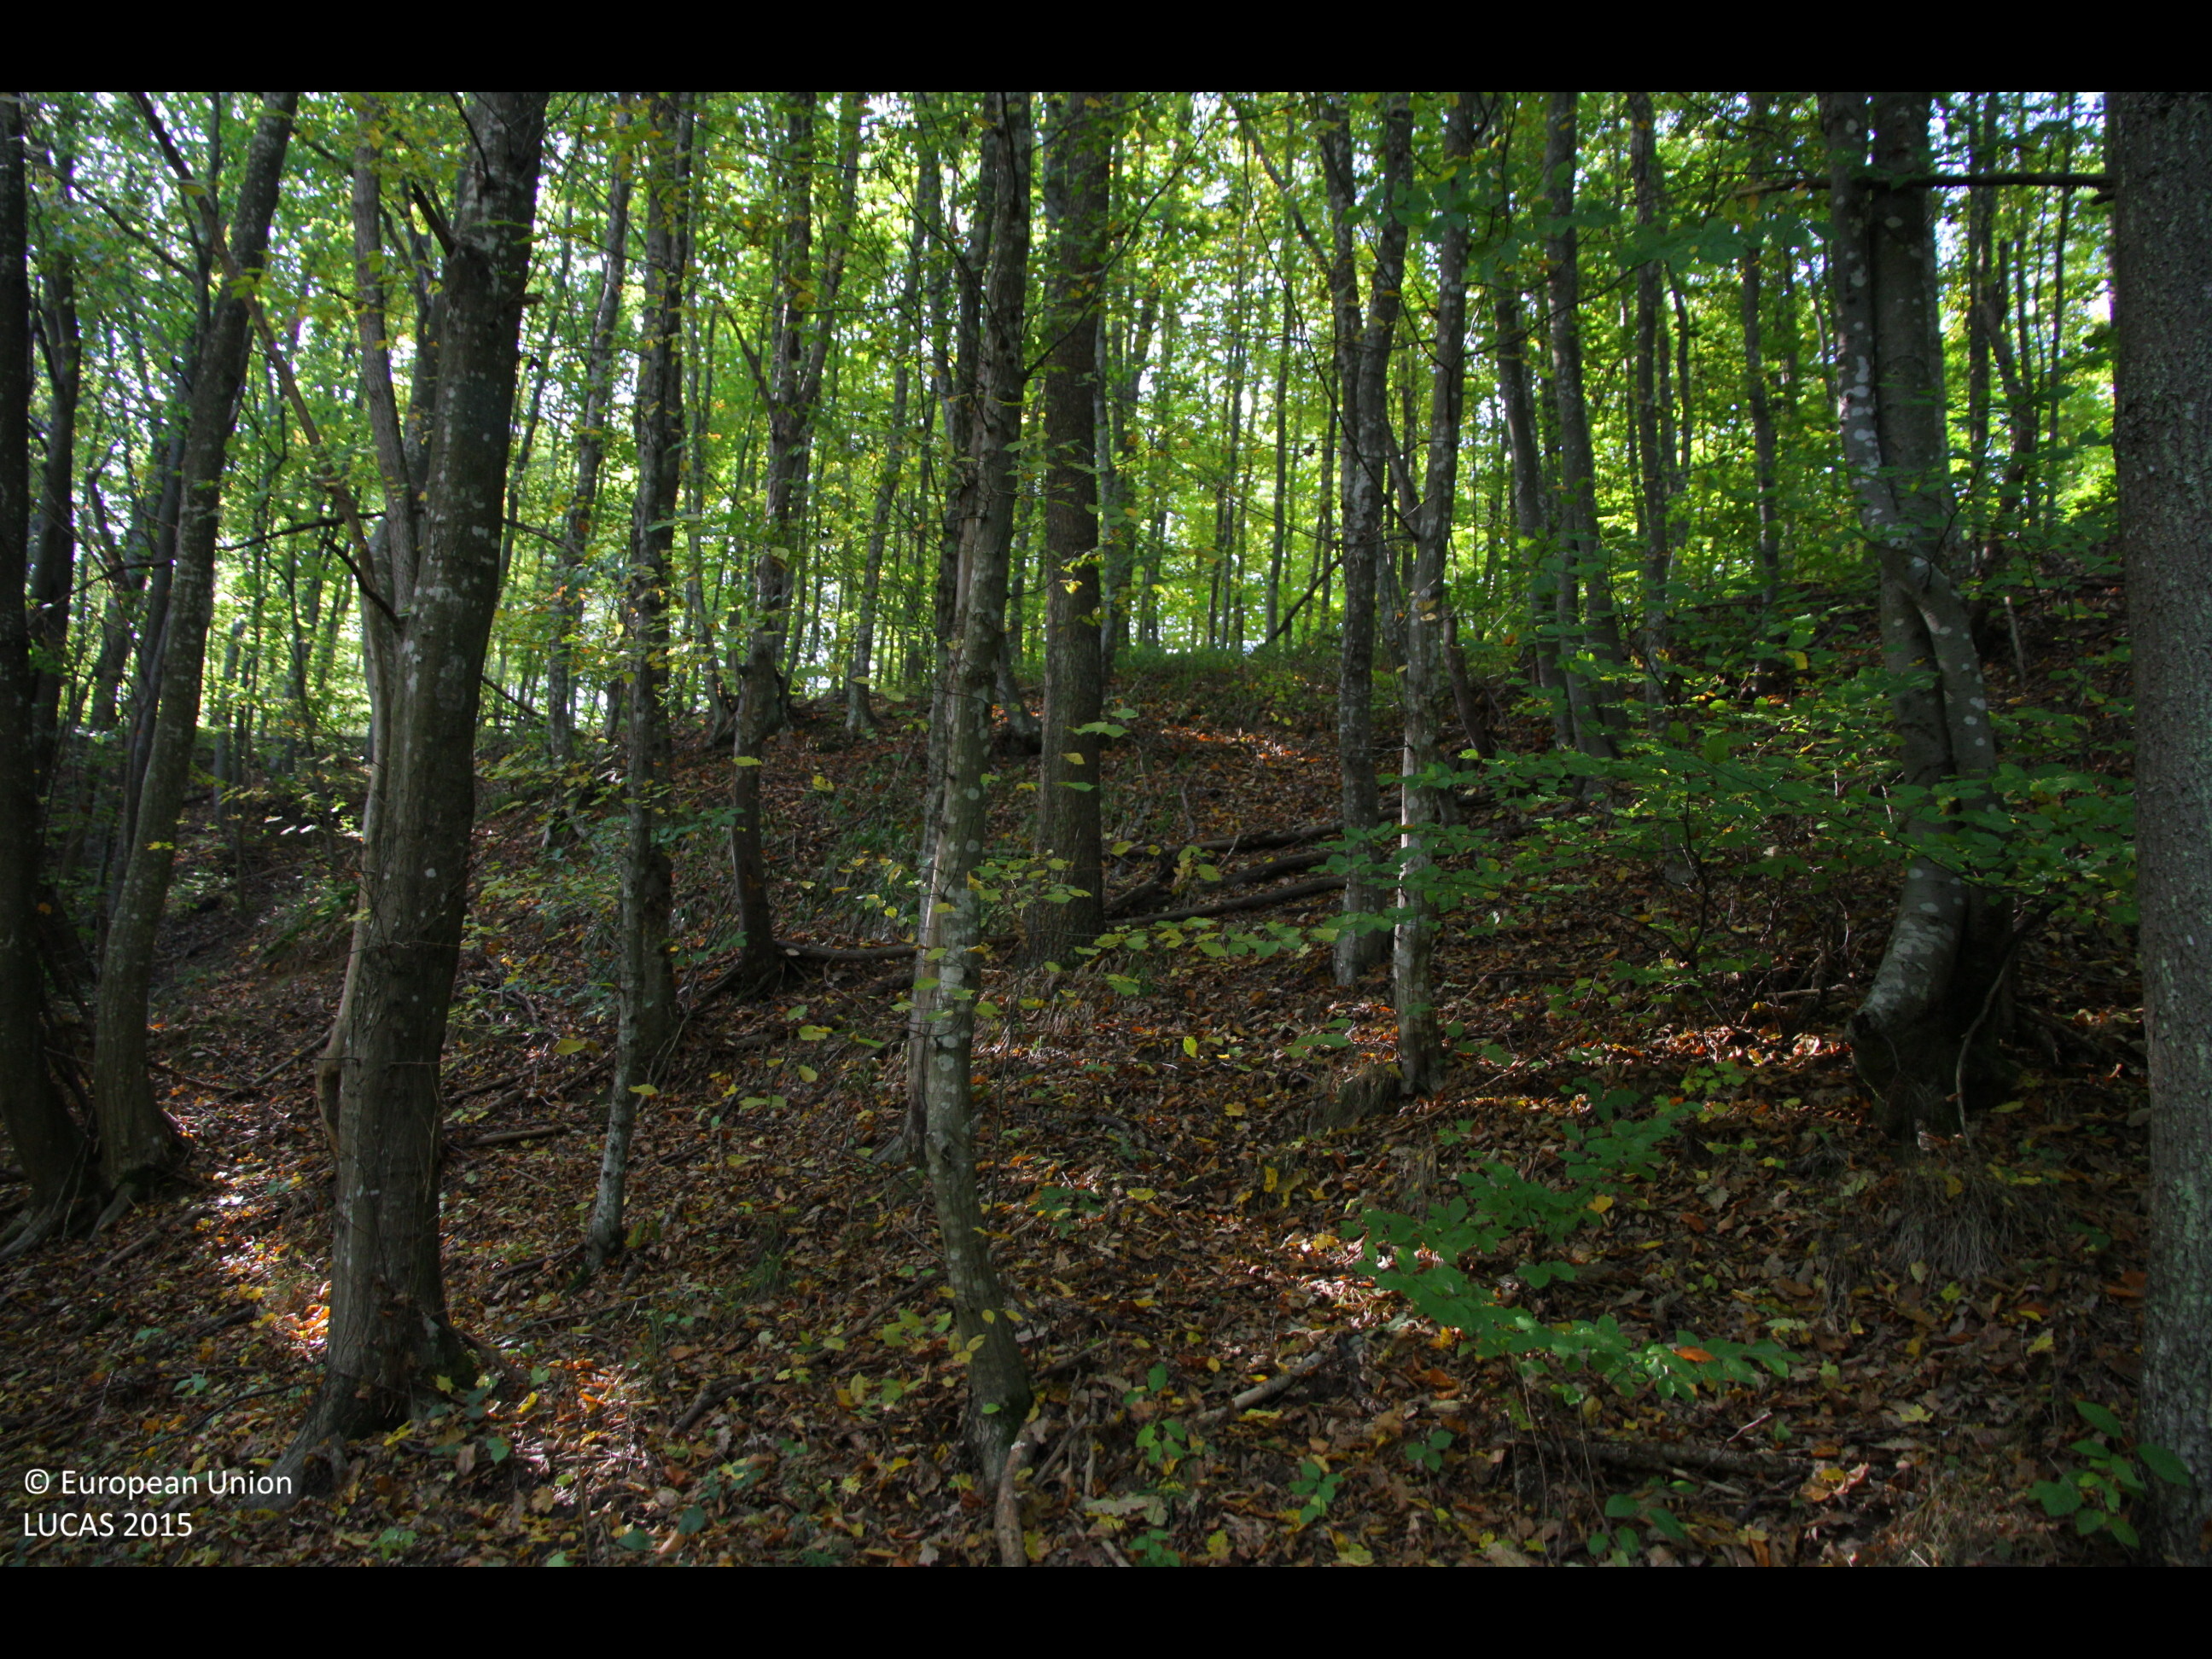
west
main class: Woodland
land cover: Broadleaved woodland
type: beech forest
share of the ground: > 75 %
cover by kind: broadleaved forest trees 100 %
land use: Forestry
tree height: > 5 m
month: October
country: BG
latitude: 42.9756
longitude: 26.8695
